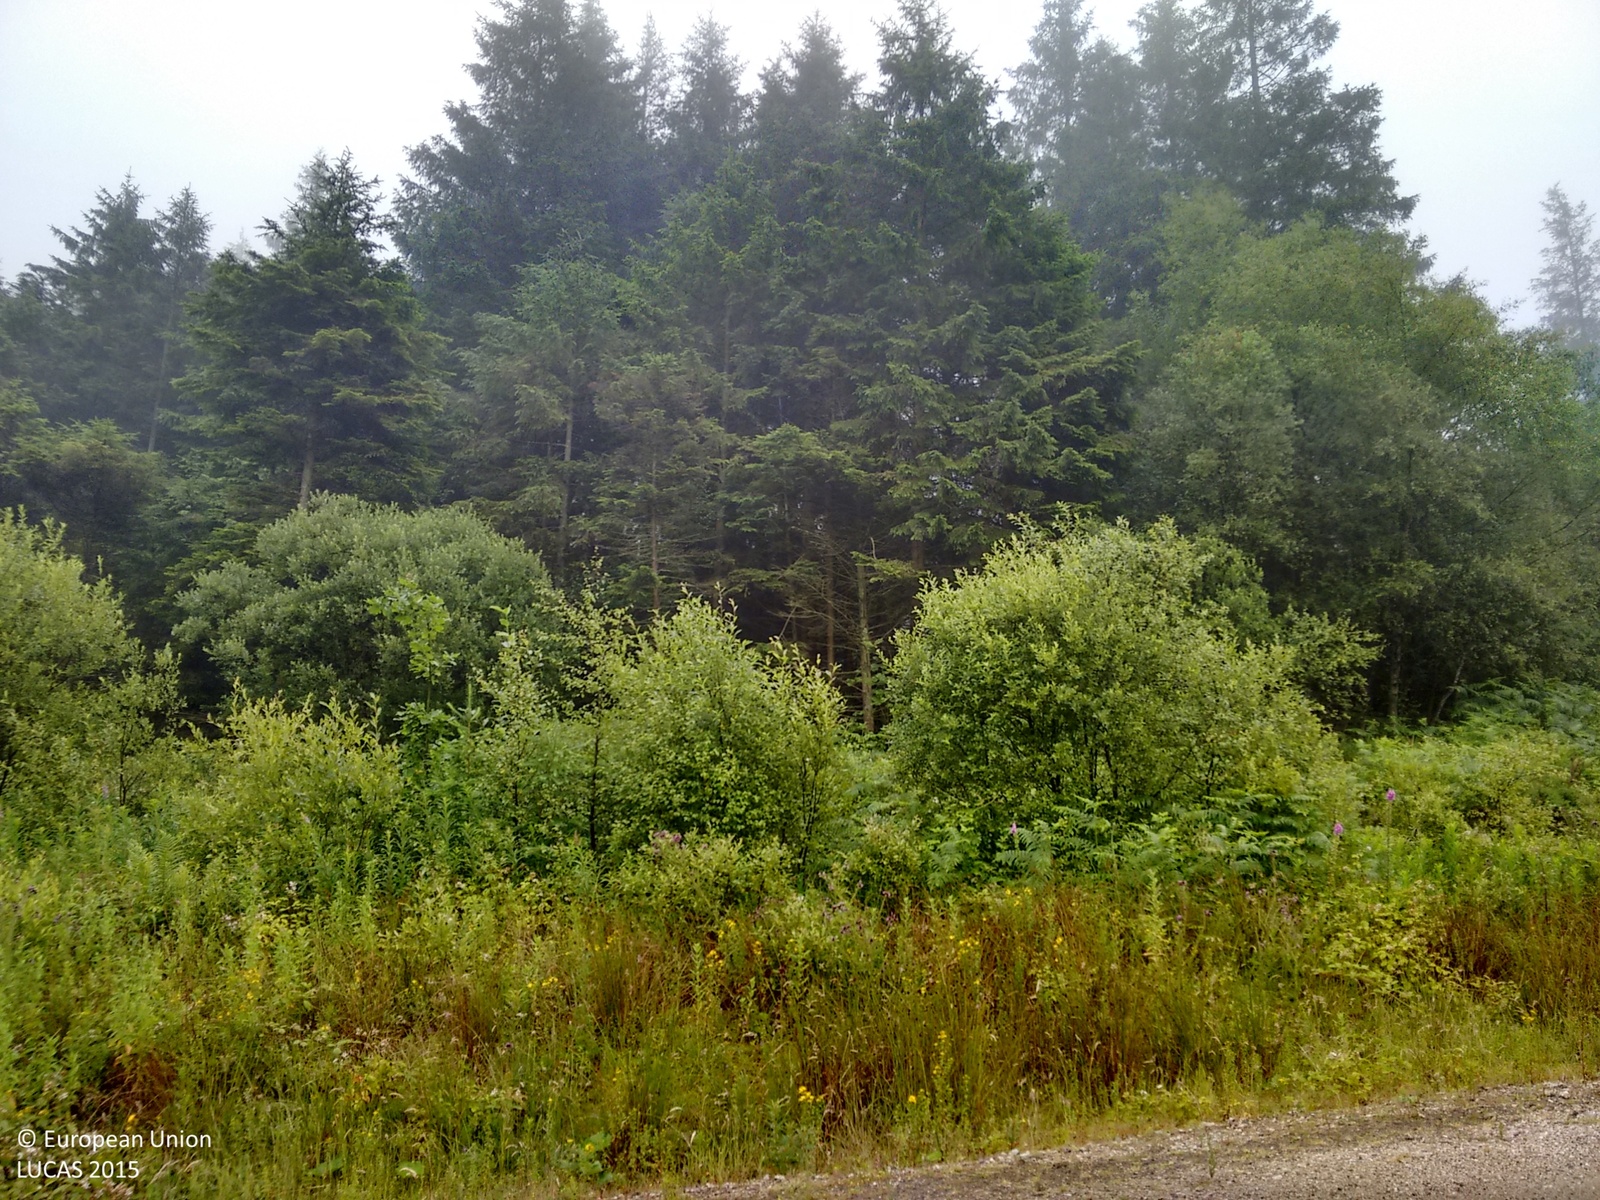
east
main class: Shrubland
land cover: Shrubland with sparse tree cover
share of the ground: > 75 %
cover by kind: shrubs 75 %, herbaceous plants 20 %, coniferous forest trees 5 %
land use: Forestry
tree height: > 5 m
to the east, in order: Shrubland with sparse tree cover; Grass margins; Tracks; Grass margins; Shrubland with sparse tree cover; Other mixed woodland; Ditches and canals; Other mixed woodland; Shruby margins; Tracks; Shruby margins; Ditches and canals; Broadleaved woodland; Other mixed woodland
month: July
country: GB
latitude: 51.7195
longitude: -3.7395
